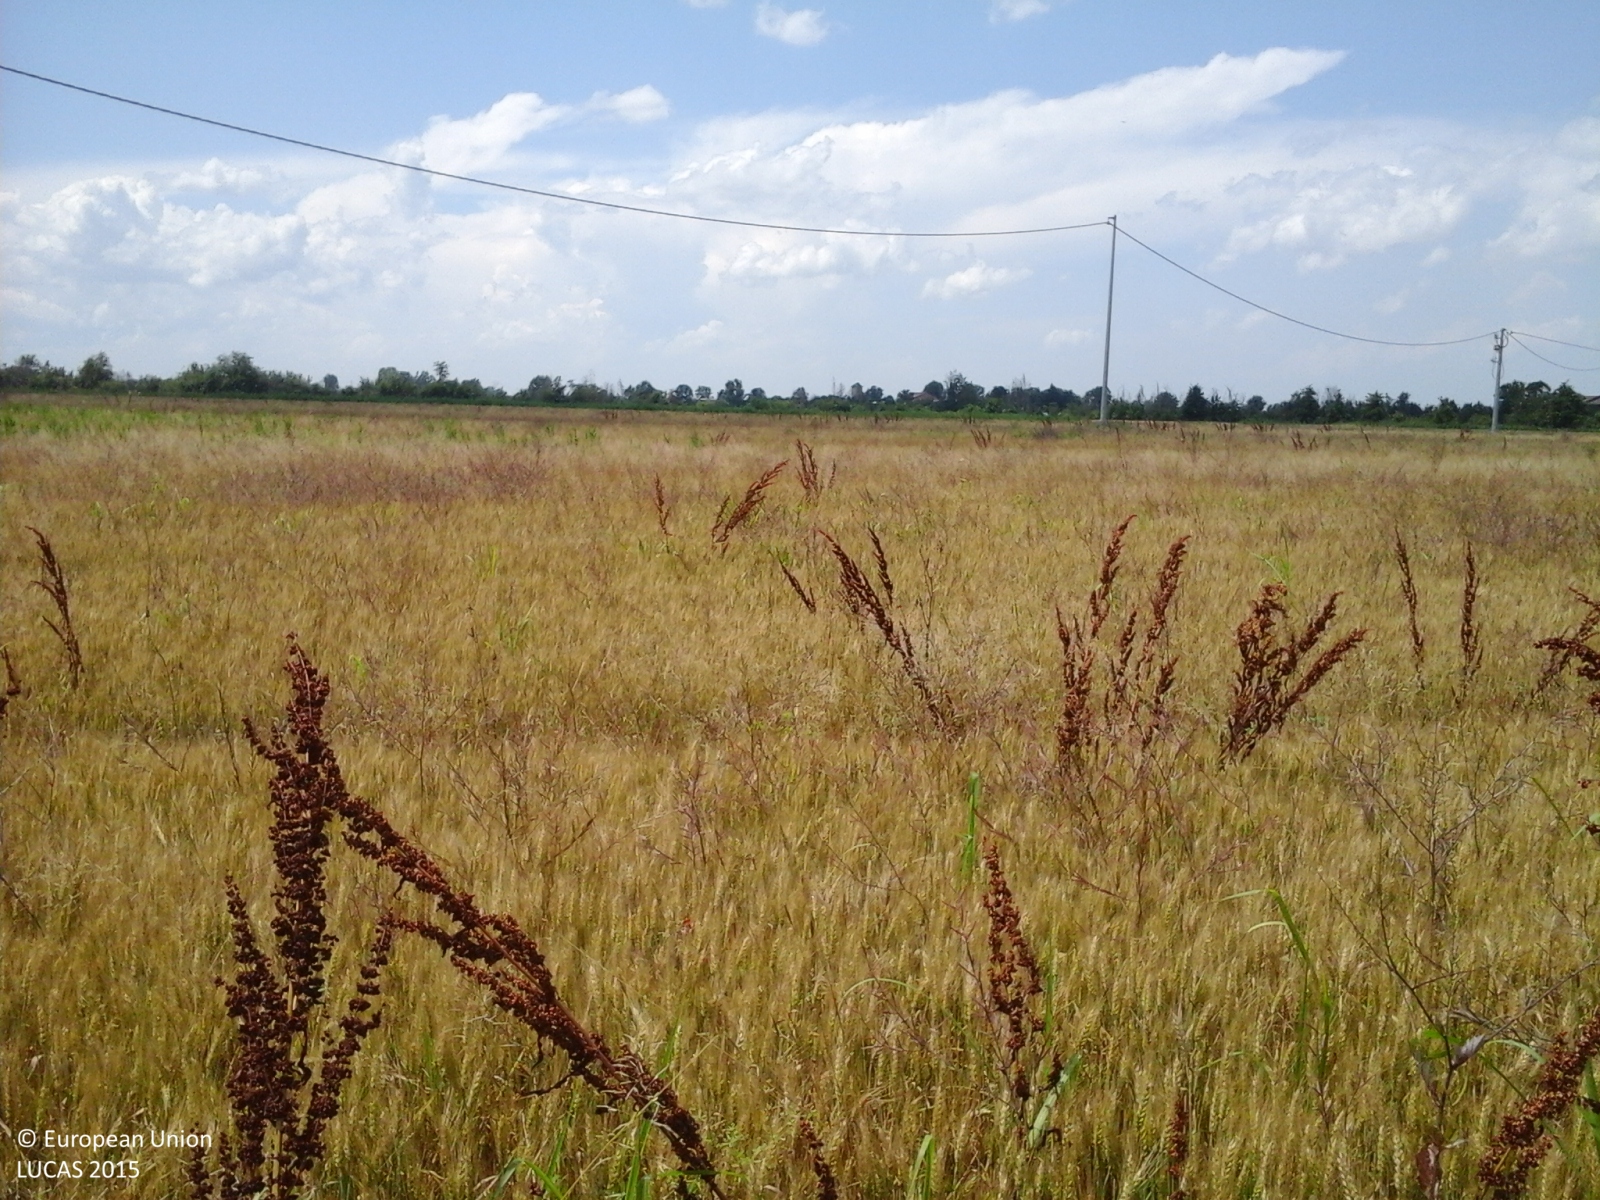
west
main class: Cropland
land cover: Durum wheat
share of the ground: > 75 %
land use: Agriculture (excluding fallow land and kitchen gardens)
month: June
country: IT
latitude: 44.7818
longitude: 10.5675
